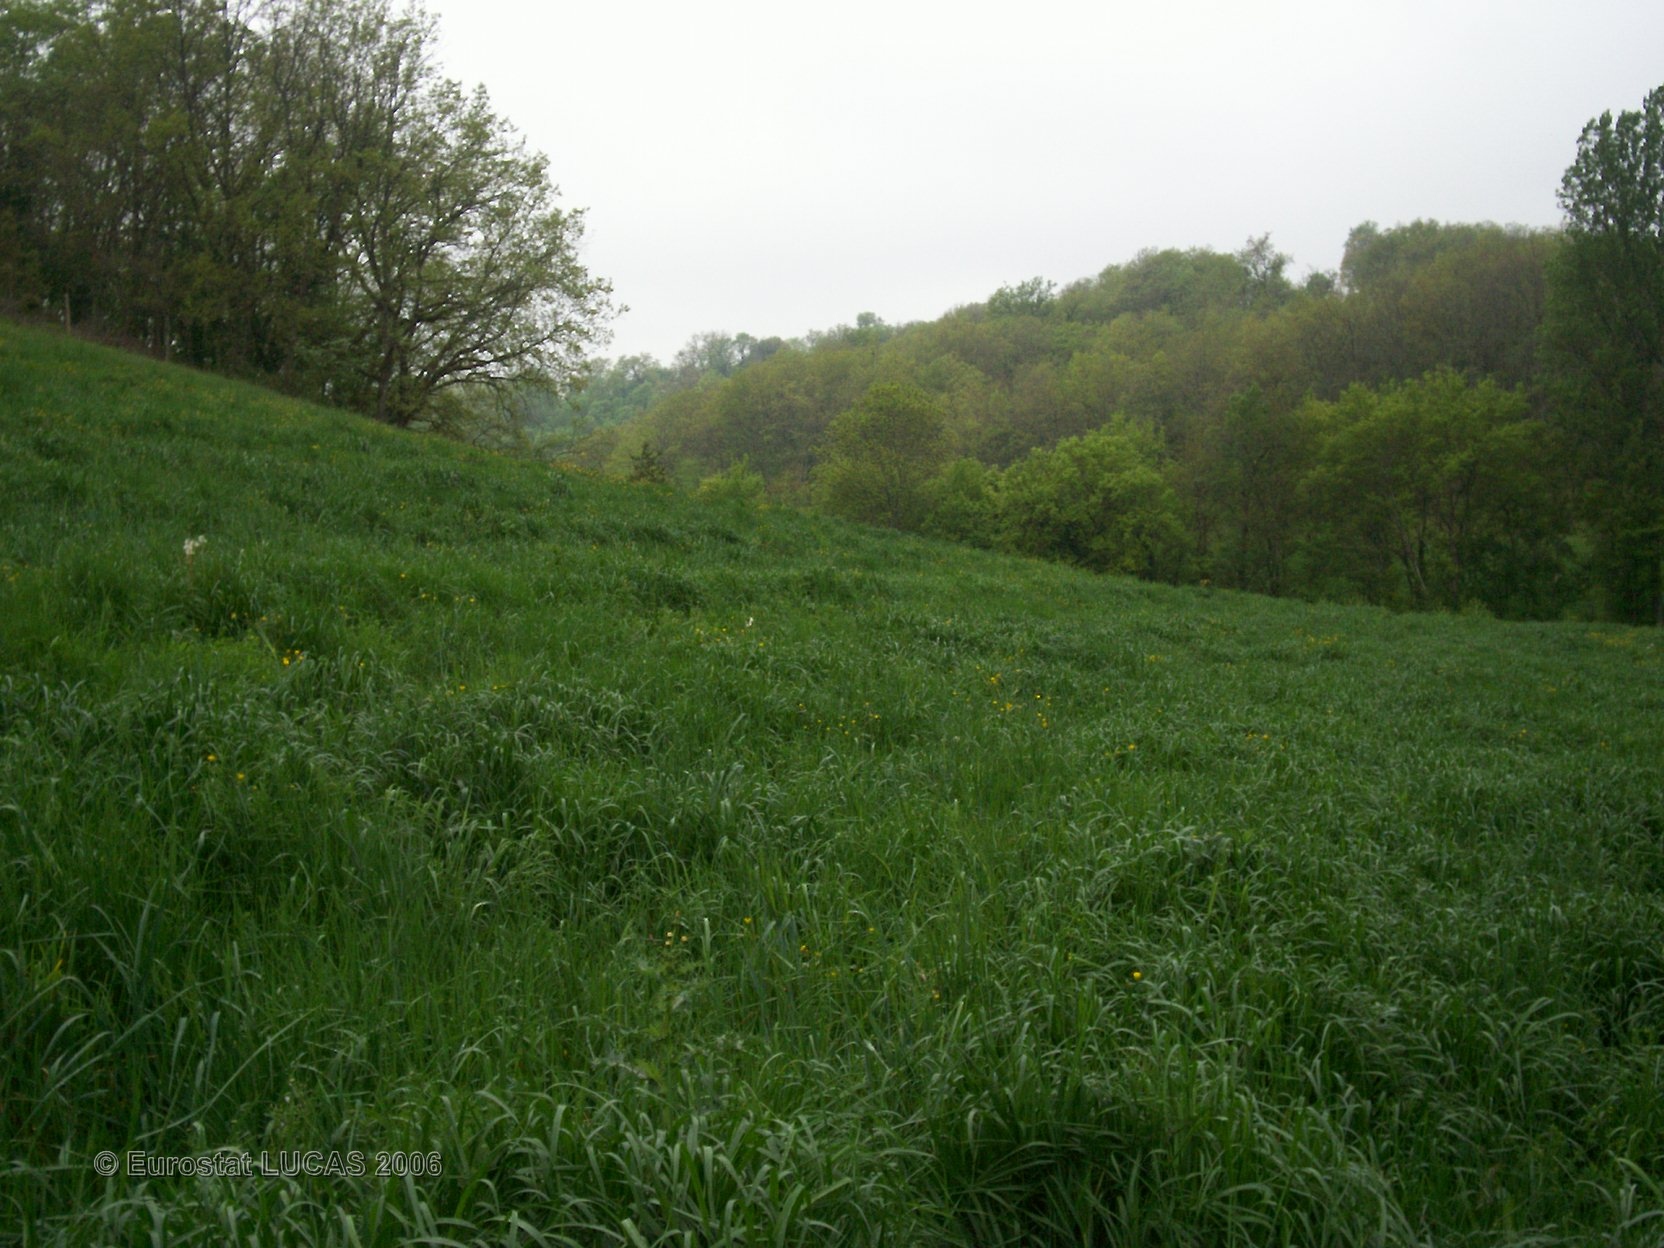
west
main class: Grassland
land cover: Grassland without tree/shrub cover
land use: Agriculture (excluding fallow land and kitchen gardens)
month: April
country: FR
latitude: 44.2196
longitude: 0.8712
